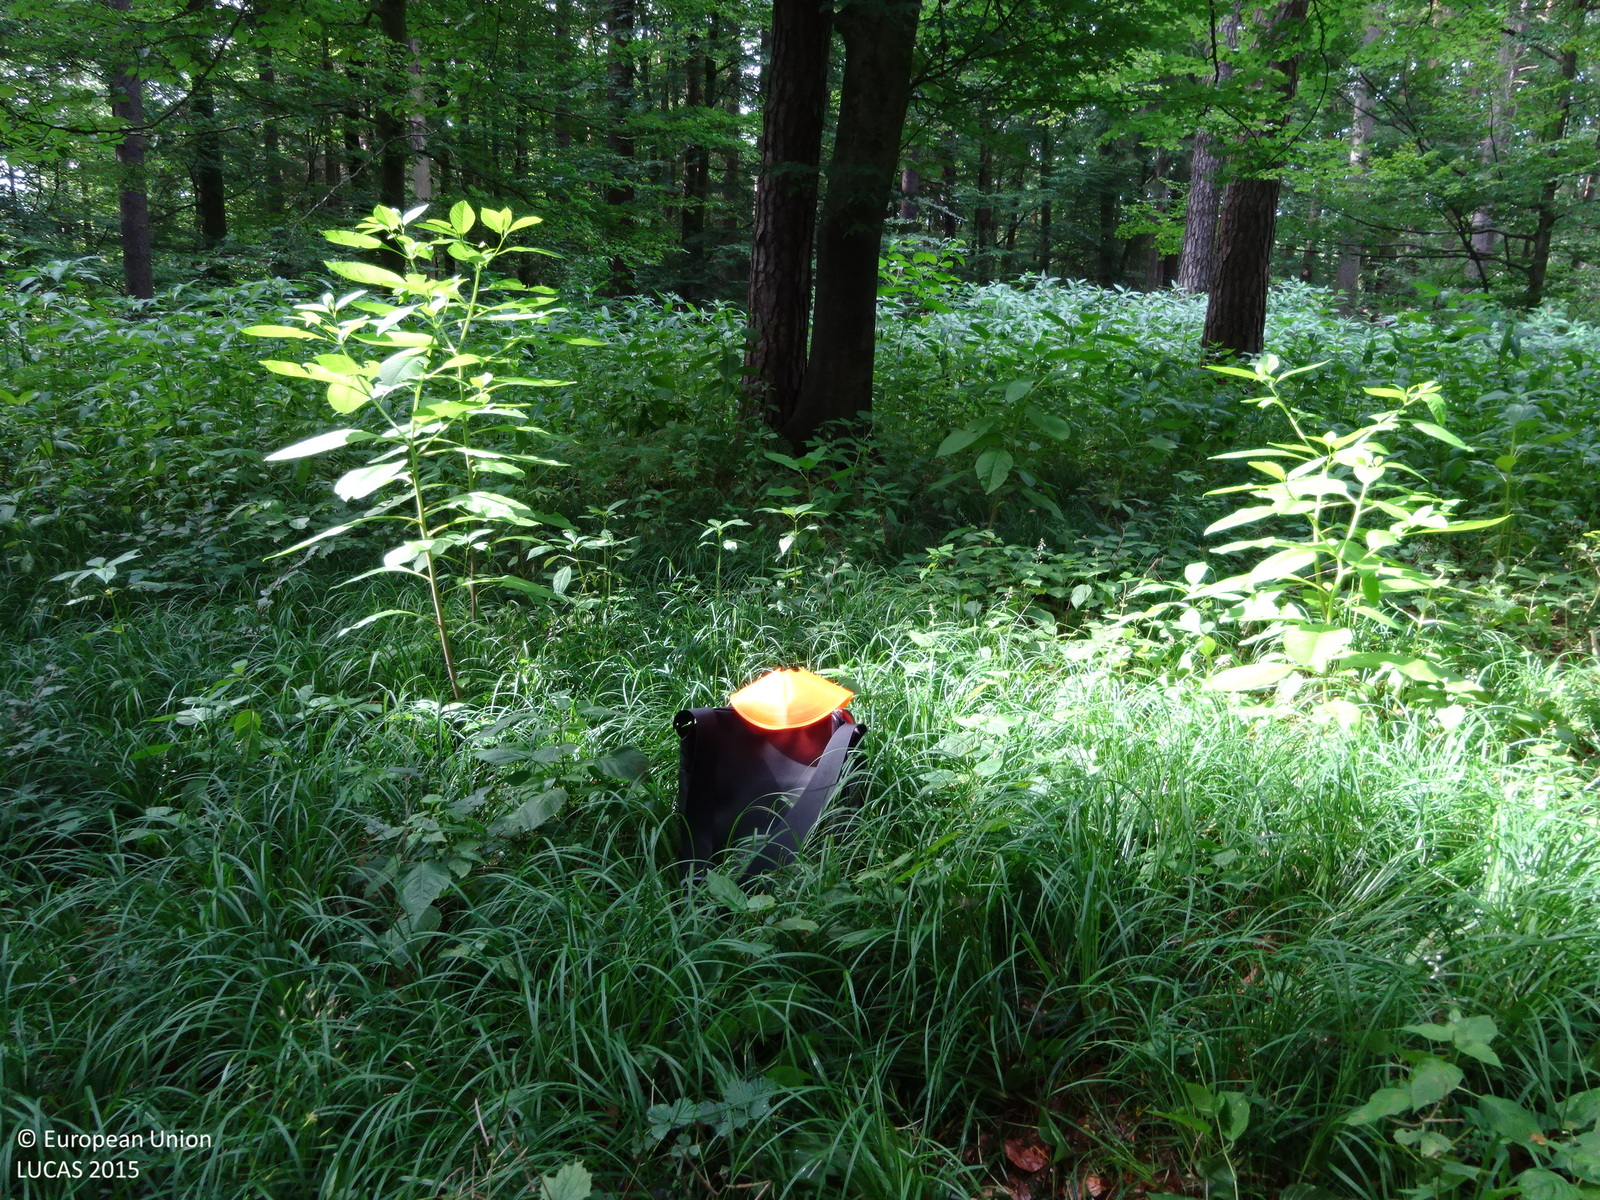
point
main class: Woodland
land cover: Other mixed woodland
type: hemiboreal forest and nemoral coniferous forest and mixed broadleaved-coniferous forest
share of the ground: > 75 %
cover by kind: broadleaved forest trees 65 %, coniferous forest trees 25 %, herbaceous plants 10 %
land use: Forestry
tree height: > 5 m
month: July
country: AT
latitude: 46.9009
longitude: 15.3946
